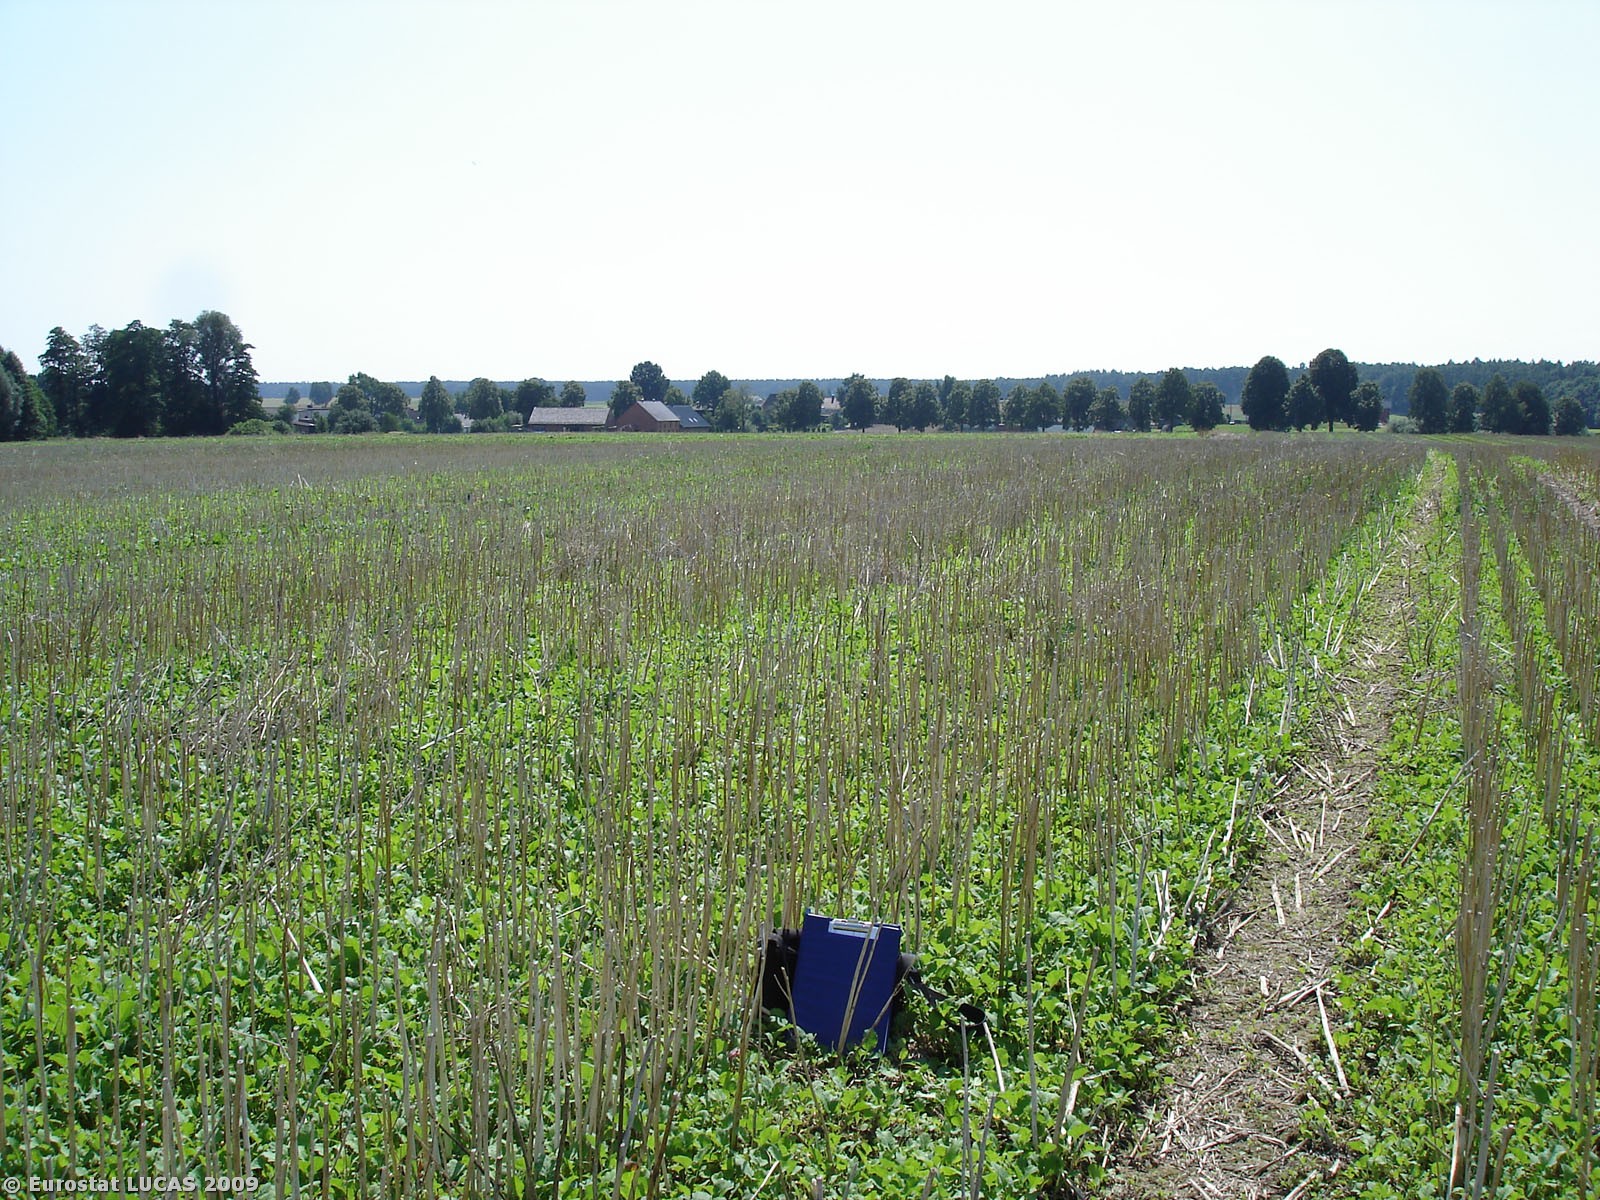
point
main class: Cropland
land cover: Other fibre and oleaginous crops
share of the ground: < 10 %
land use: Agriculture (excluding fallow land and kitchen gardens)
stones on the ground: < 10 %
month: August
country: PL
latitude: 50.9130
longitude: 18.2814
